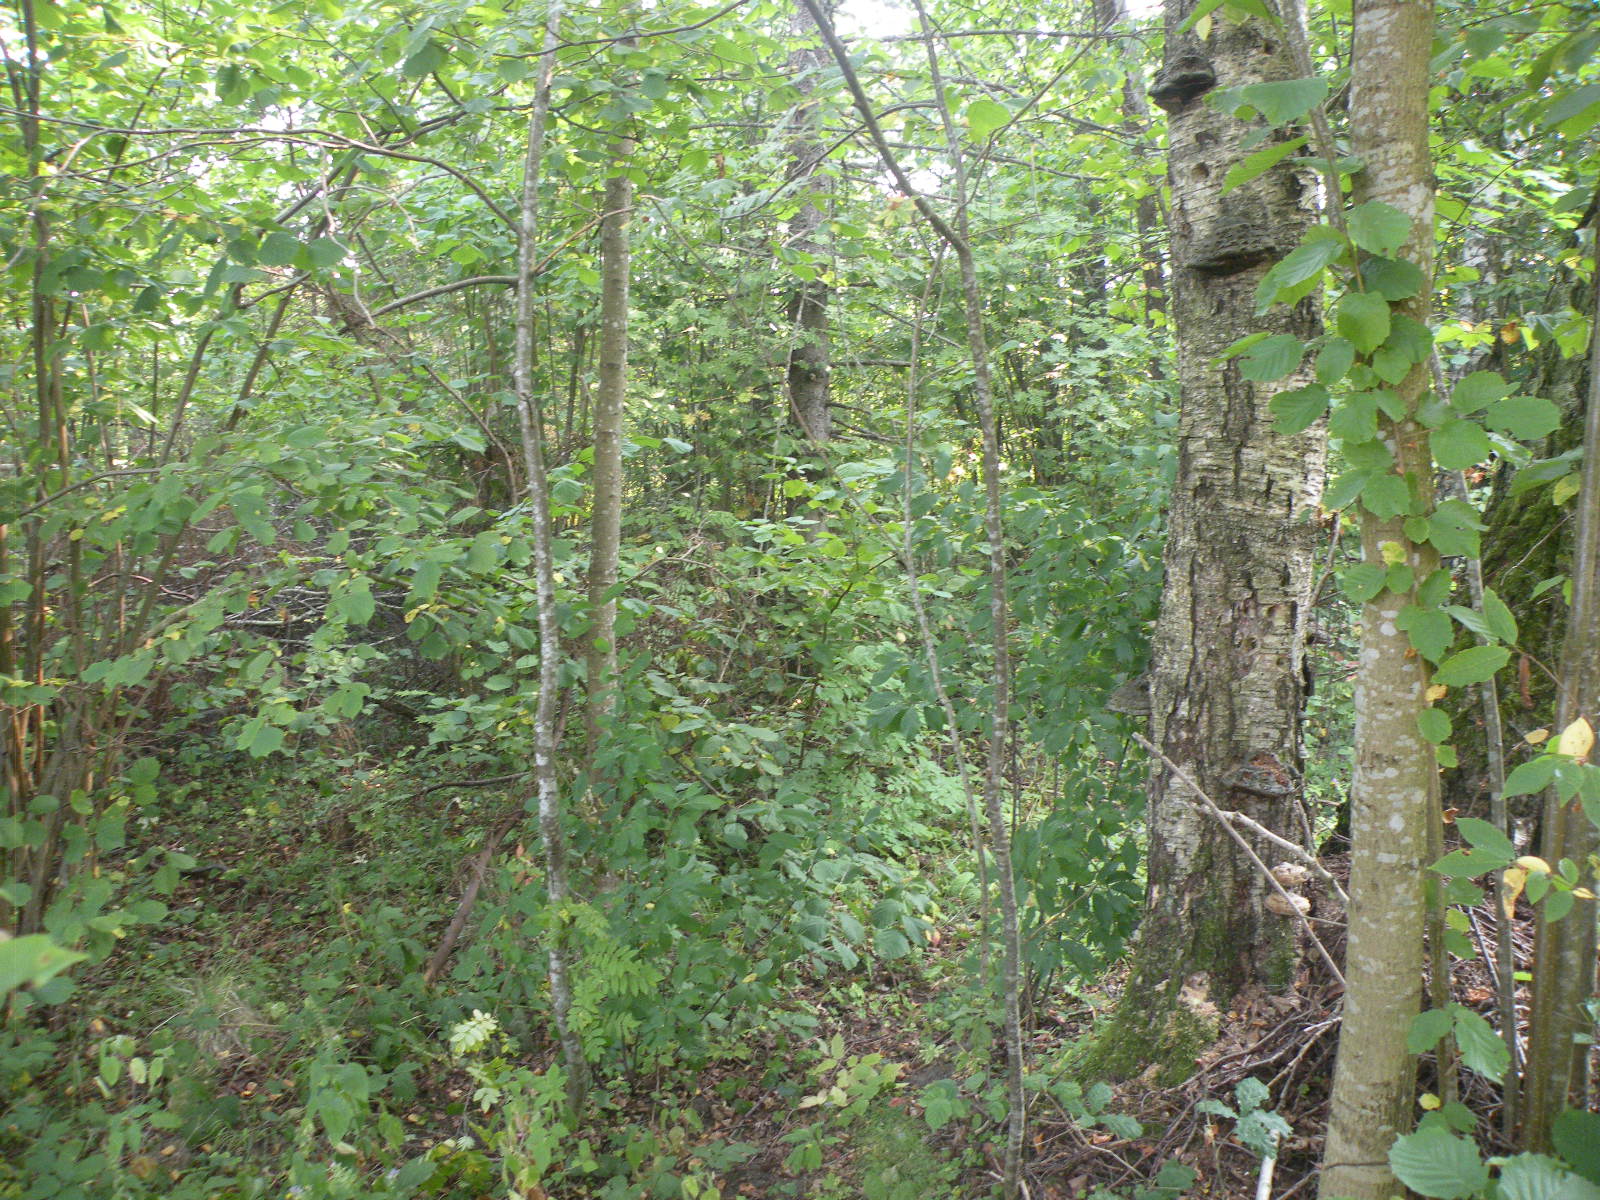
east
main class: Woodland
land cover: Spruce dominated mixed woodland
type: hemiboreal forest and nemoral coniferous forest and mixed broadleaved-coniferous forest
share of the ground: > 75 %
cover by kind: coniferous forest trees 60 %, broadleaved forest trees 25 %, herbaceous plants 10 %, shrubs 5 %
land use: Forestry
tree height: > 5 m
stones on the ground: < 10 %
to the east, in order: Spruce dominated mixed woodland; Ditches and canals; Spruce dominated mixed woodland; Peatbogs; Spruce dominated mixed woodland; Rivers and streams; Spruce dominated mixed woodland
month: August
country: LV
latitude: 55.7730
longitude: 26.6221
